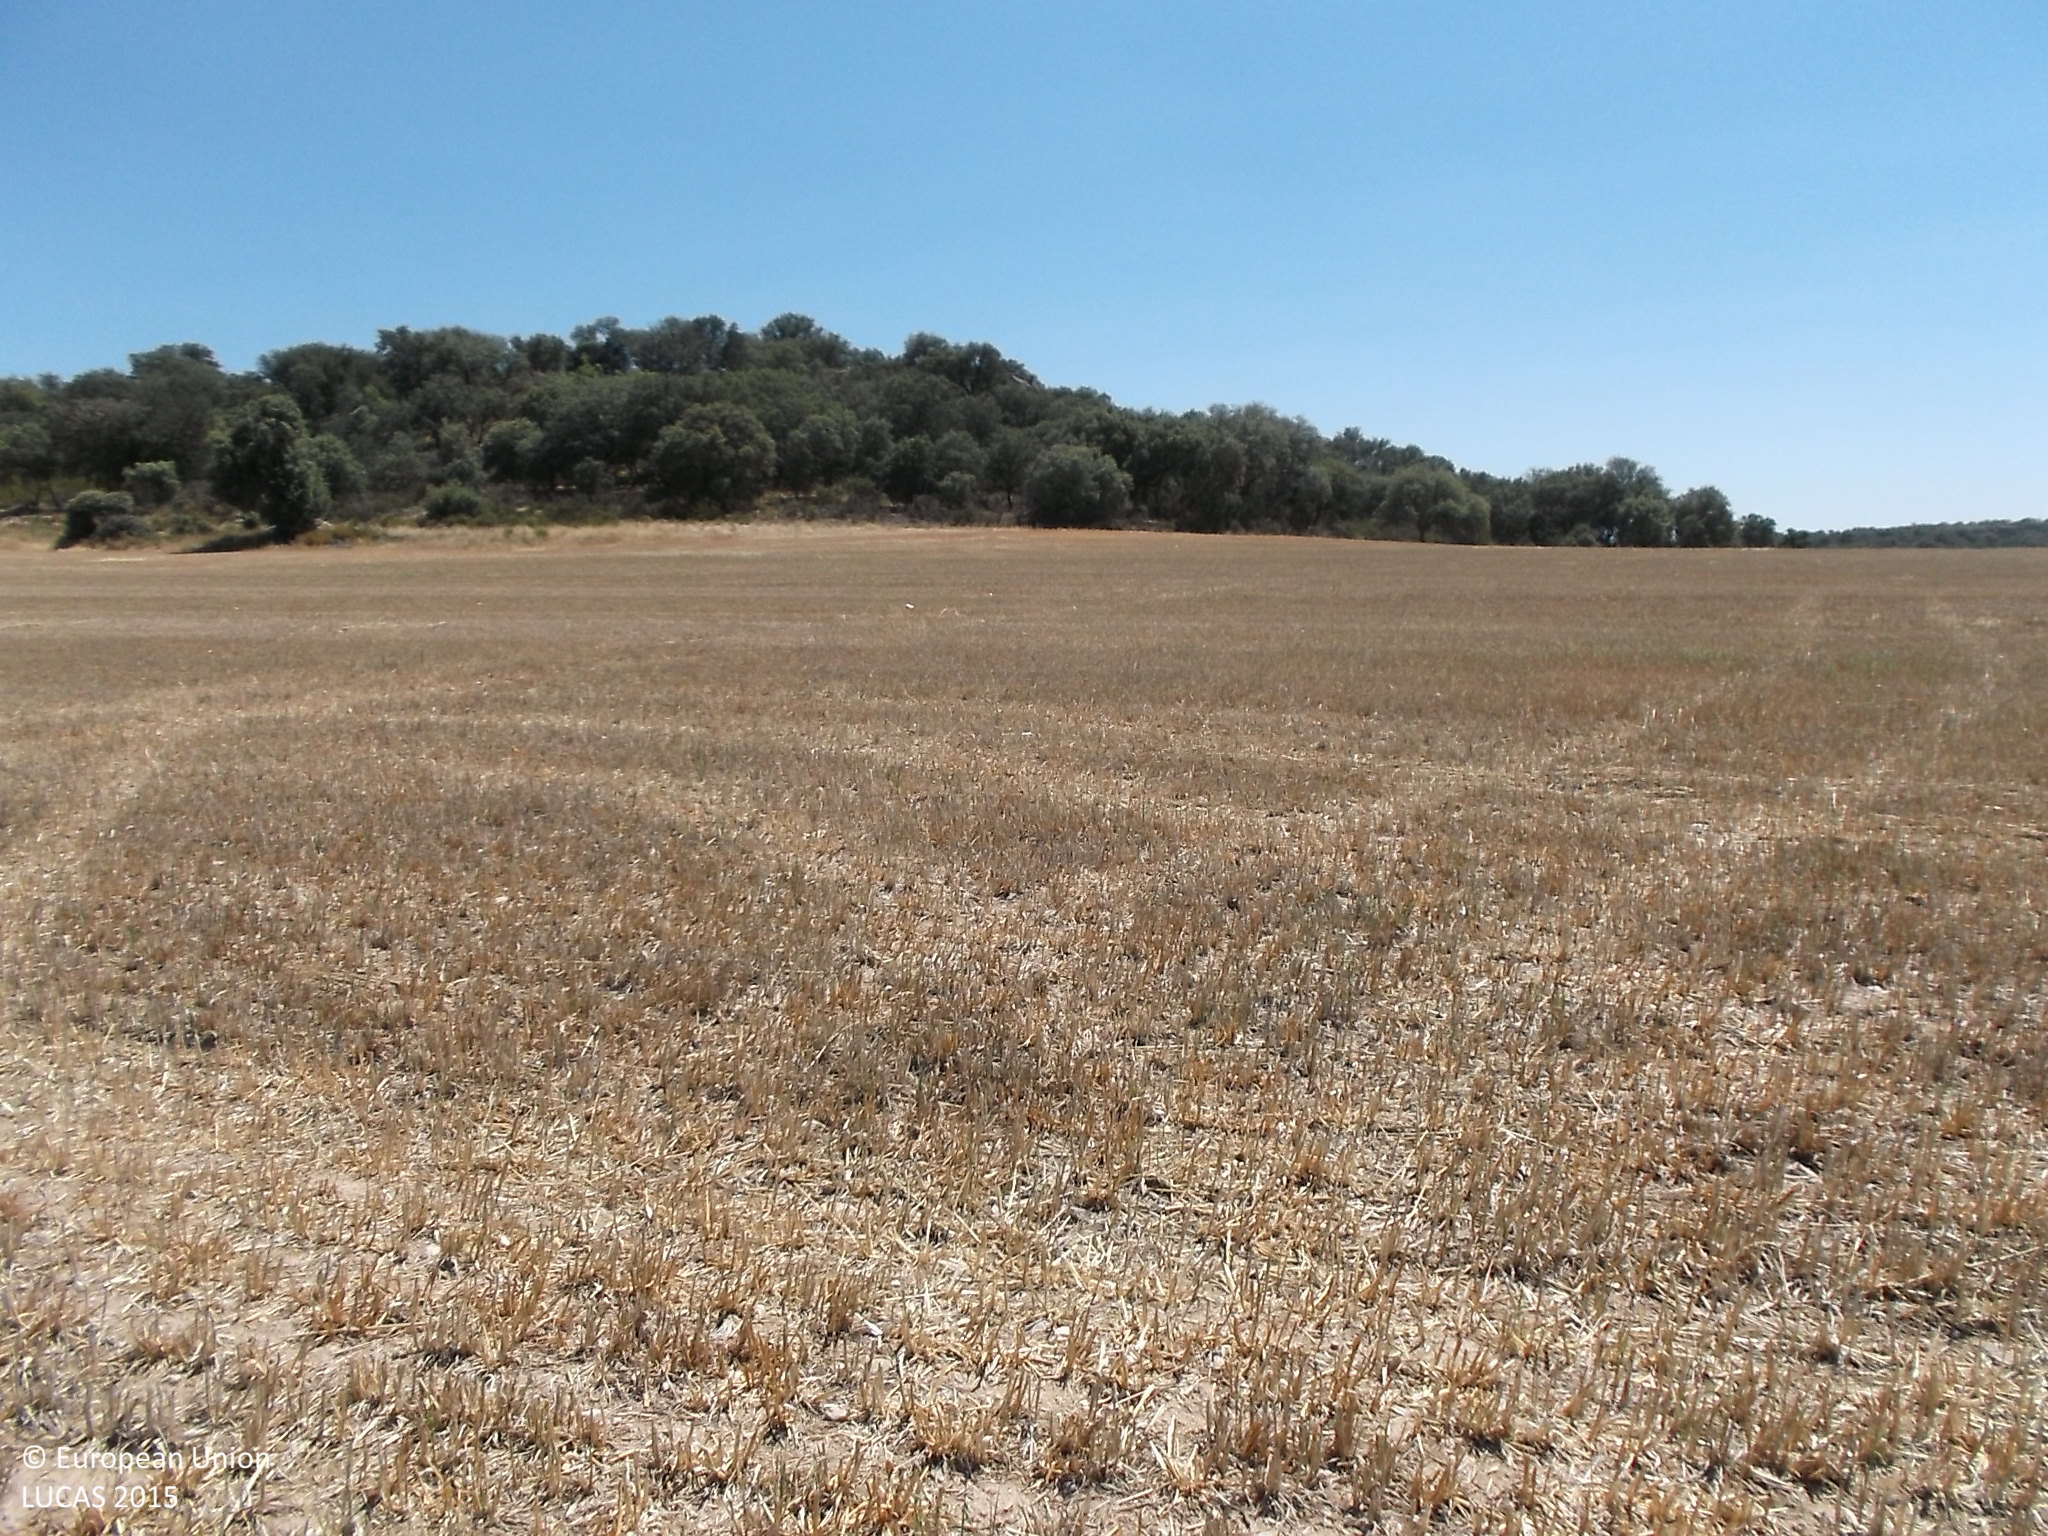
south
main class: Cropland
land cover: Oats
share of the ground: < 10 %
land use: Agriculture (excluding fallow land and kitchen gardens)
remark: Harvested field
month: July
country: ES
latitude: 41.3770
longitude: -5.8581
